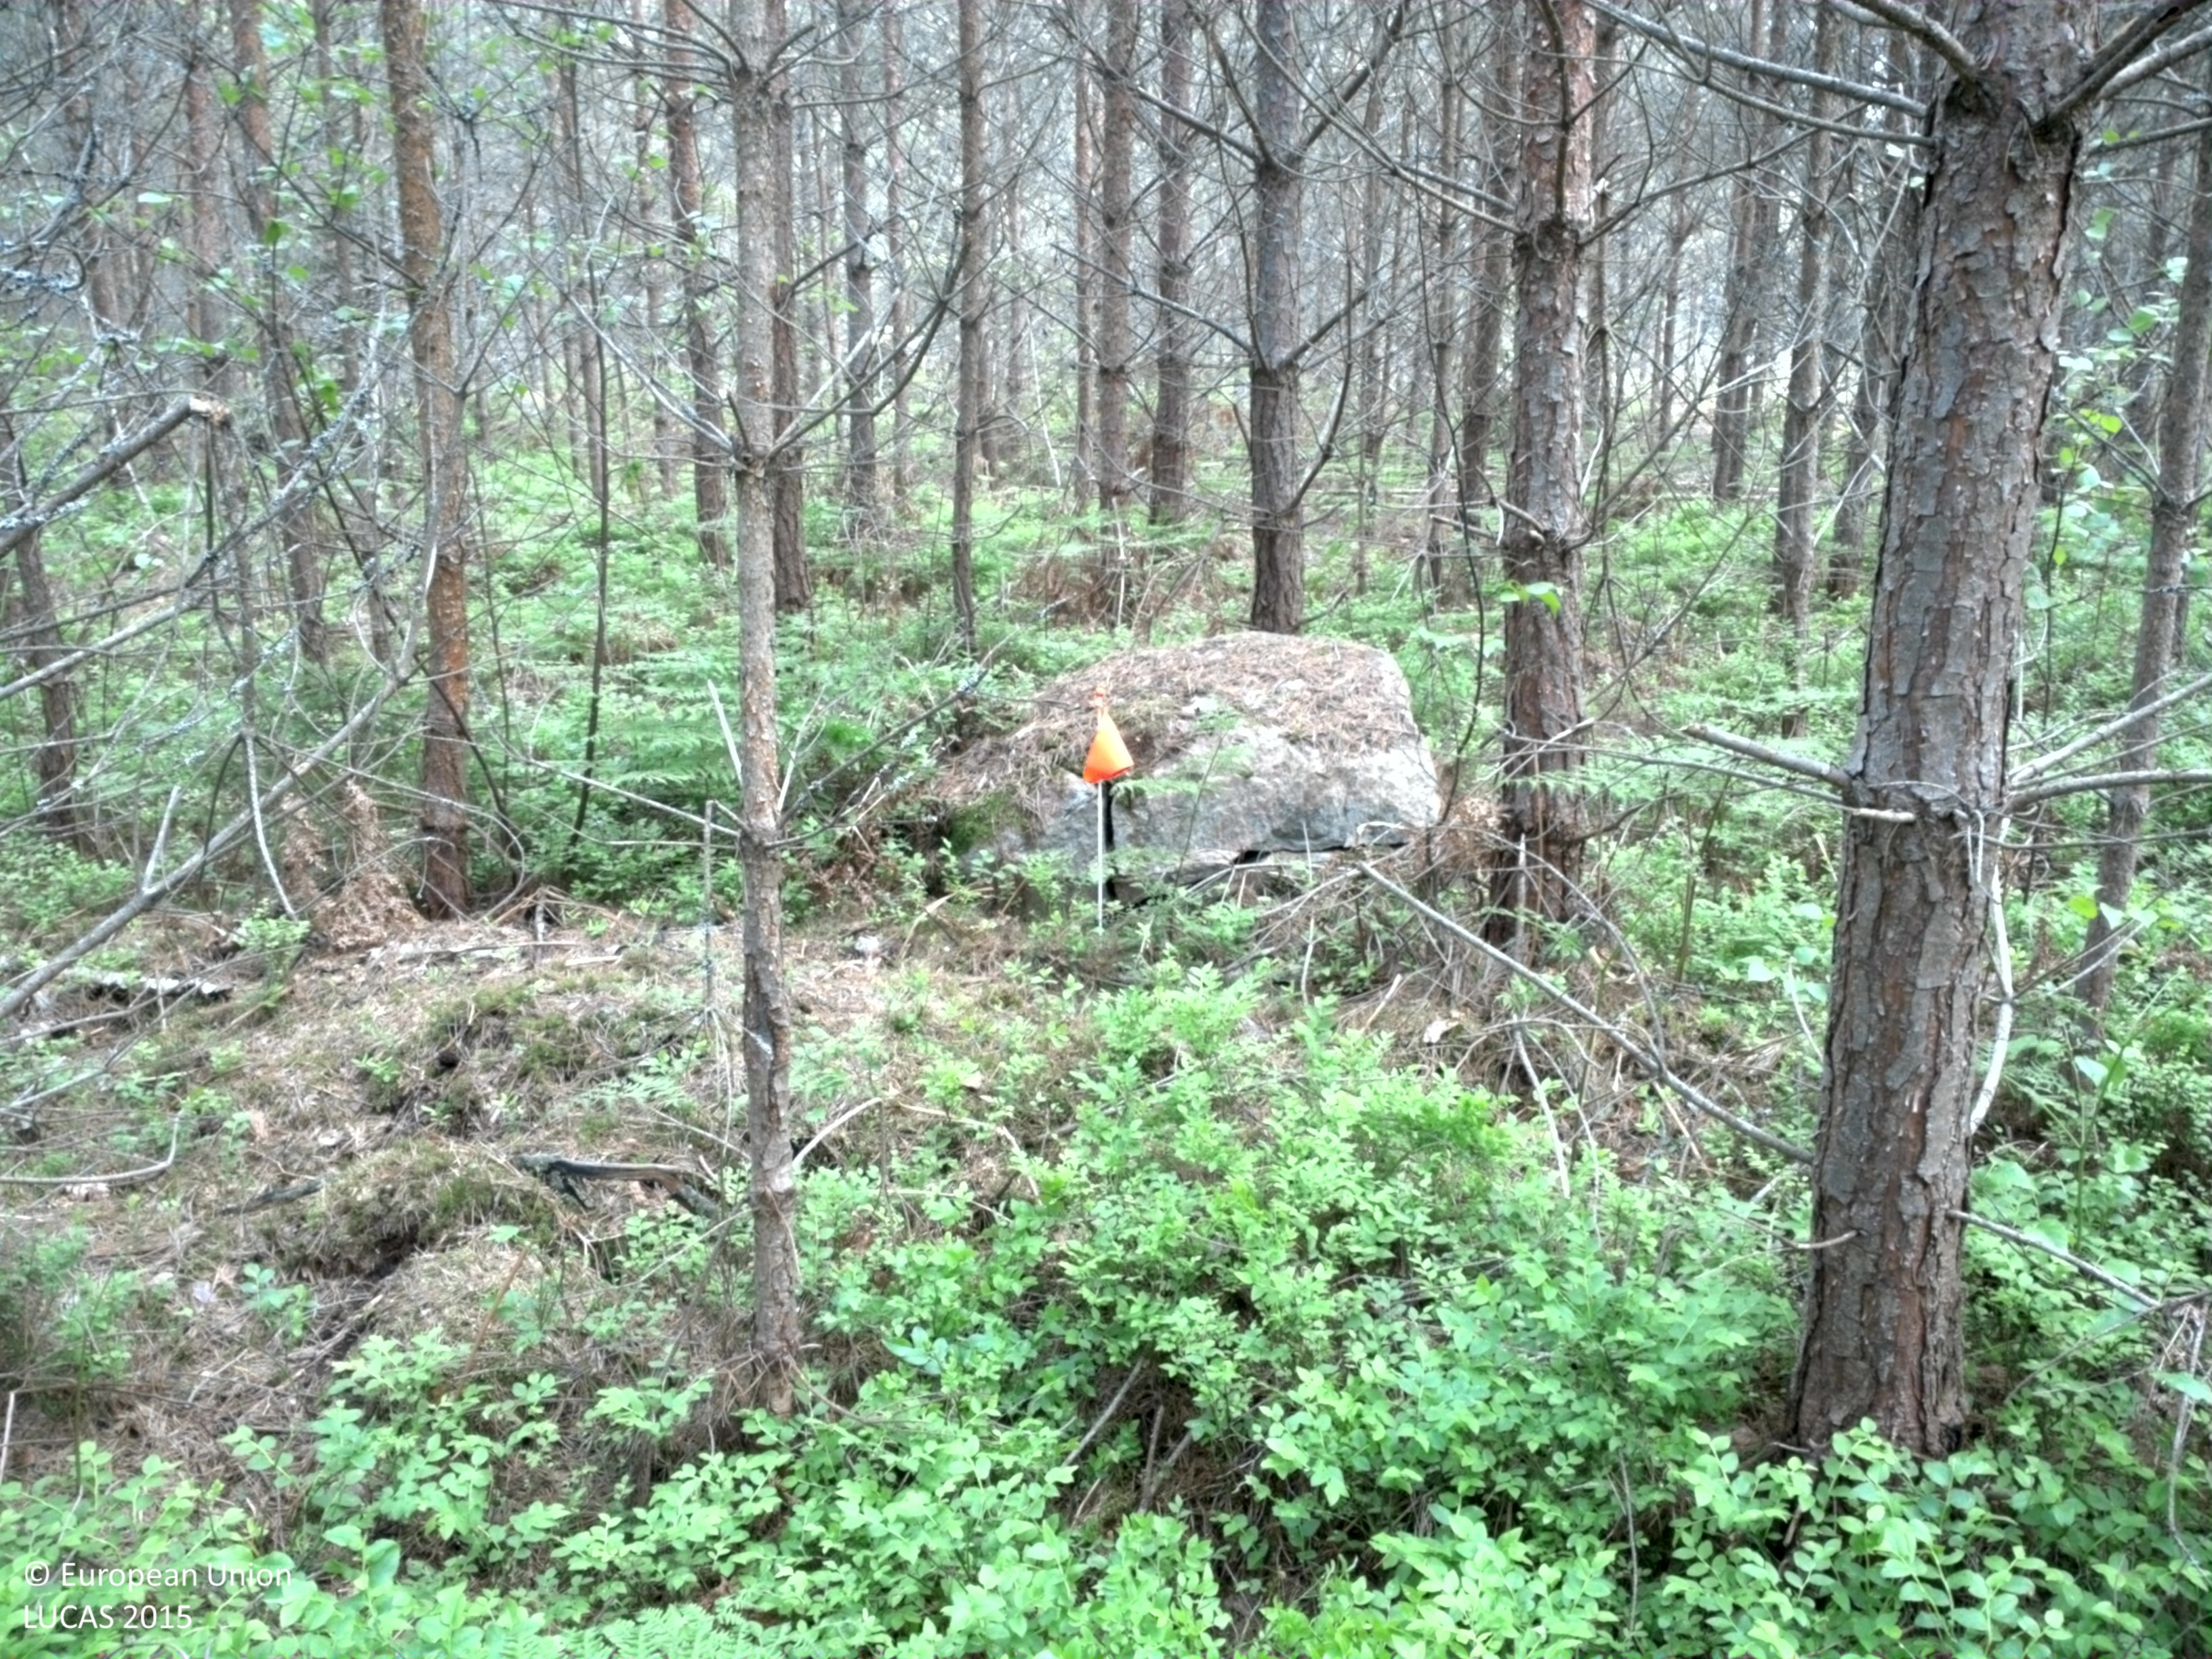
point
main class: Woodland
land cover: Pine dominated coniferous woodland
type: exotic forest
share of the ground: > 75 %
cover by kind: coniferous forest trees 85 %, shrubs 10 %, broadleaved forest trees 5 %
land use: Forestry
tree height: < 5 m
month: May
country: SE
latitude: 57.0867
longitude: 16.5183
